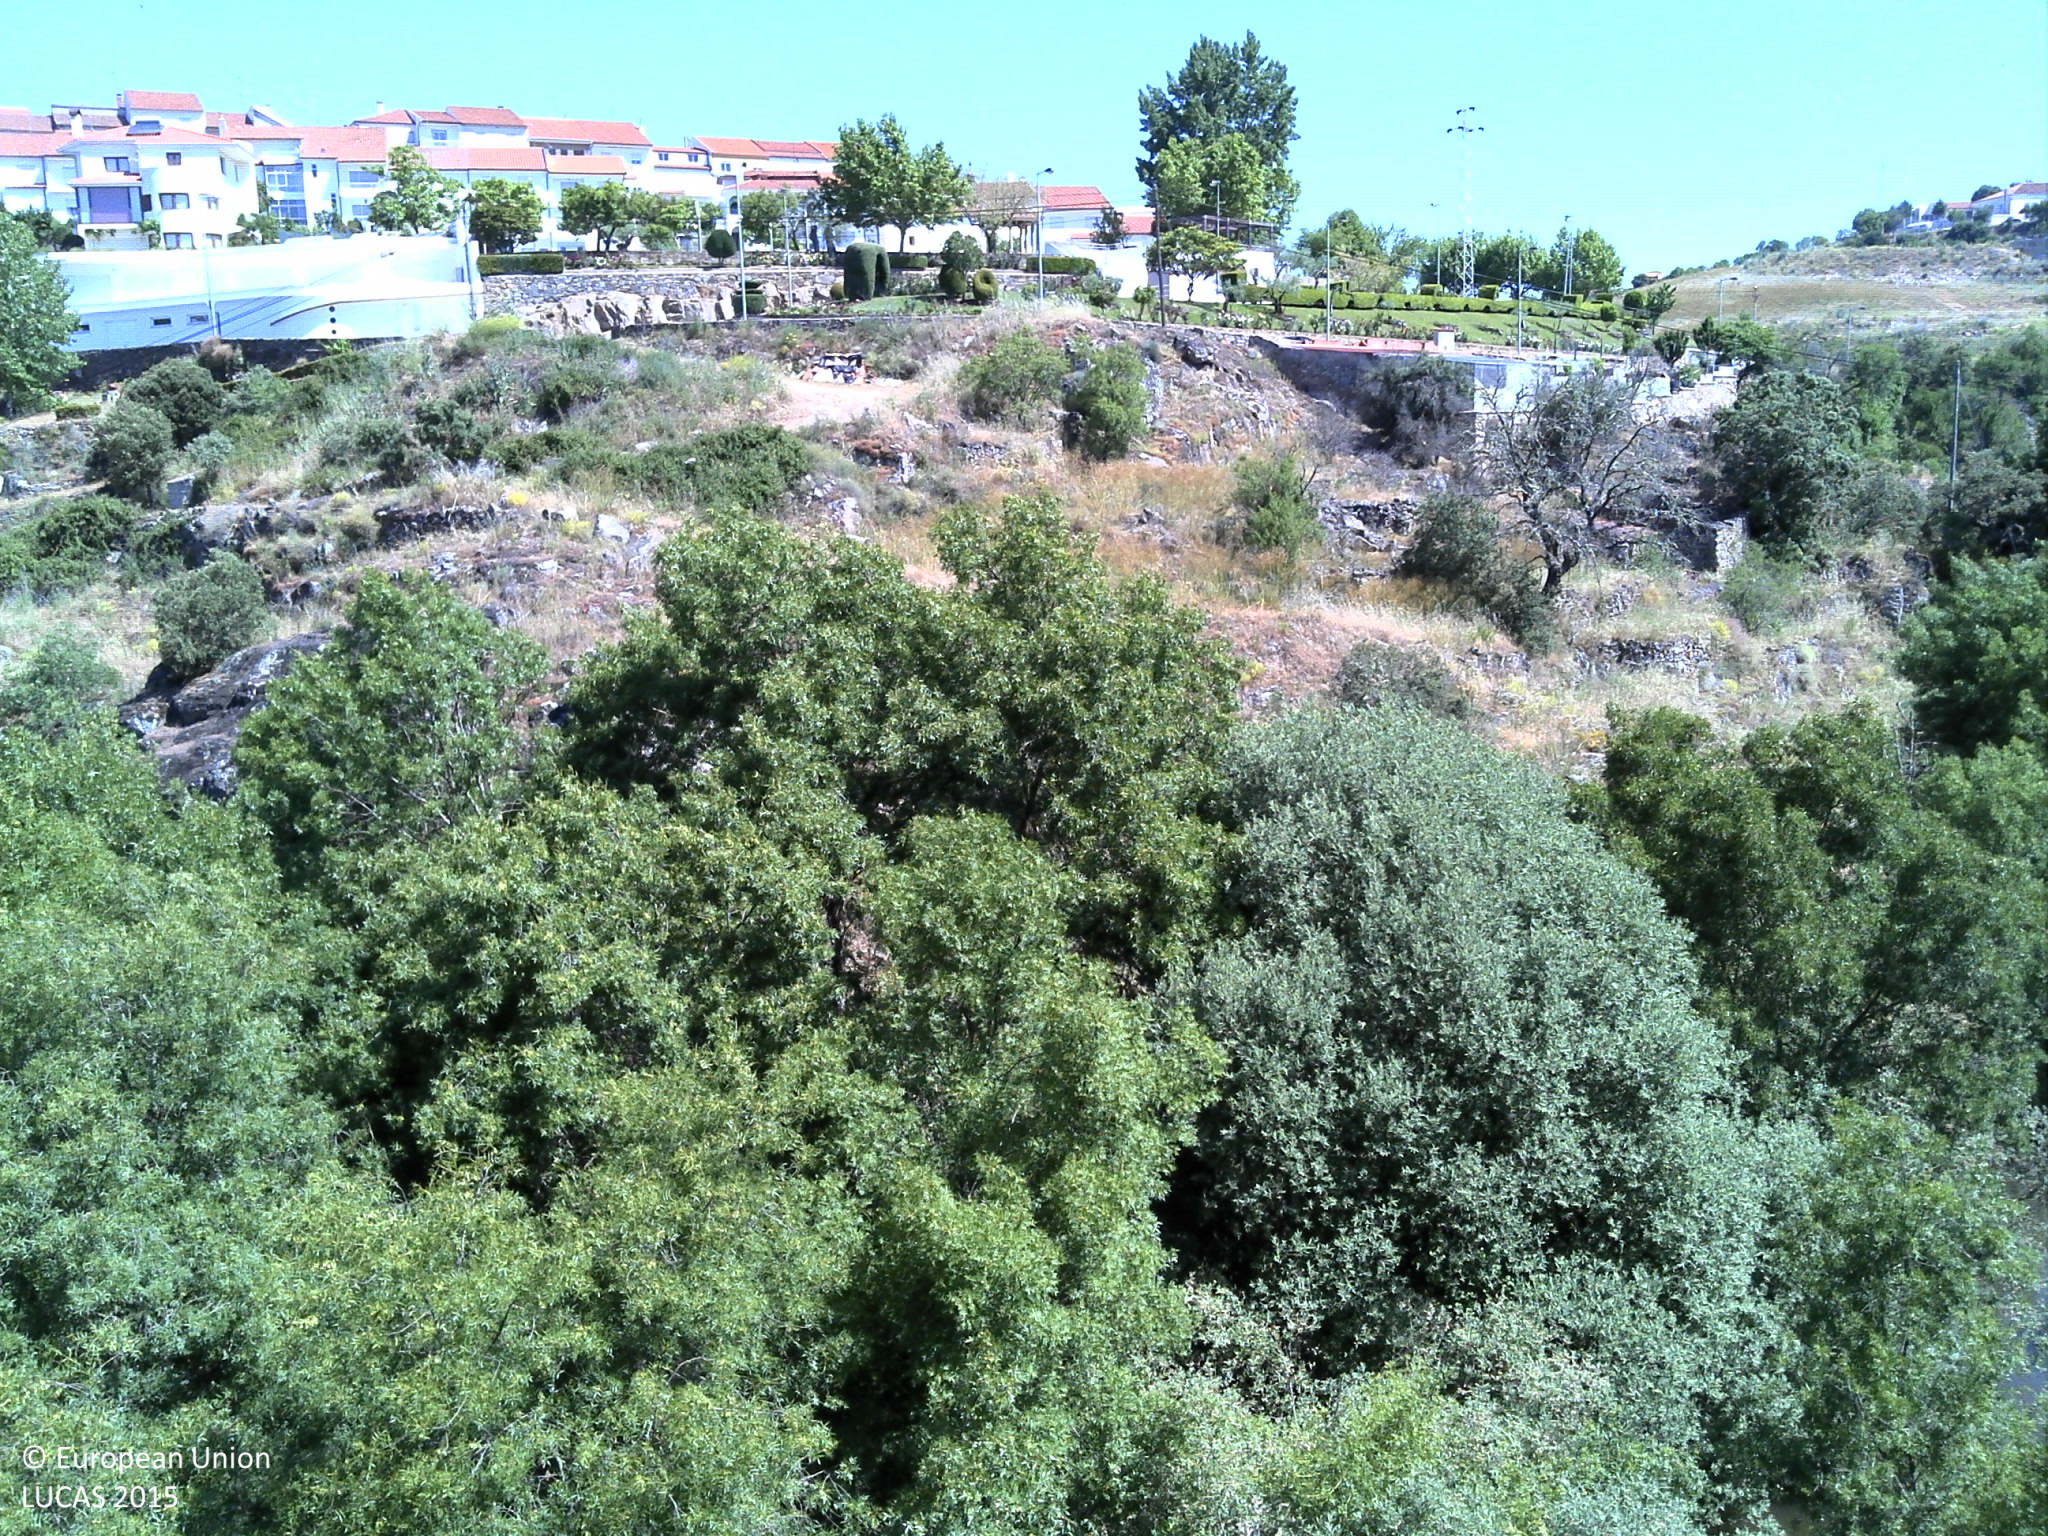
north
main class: Grassland
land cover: Grassland with sparse tree/shrub cover
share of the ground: 50 - 75 %
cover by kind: herbaceous plants 50 %, consolidated bare surface 45 %, broadleaved forest trees 5 %
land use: Semi-natural and natural areas not in use
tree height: > 5 m
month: May
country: PT
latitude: 41.4920
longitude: -6.2799
